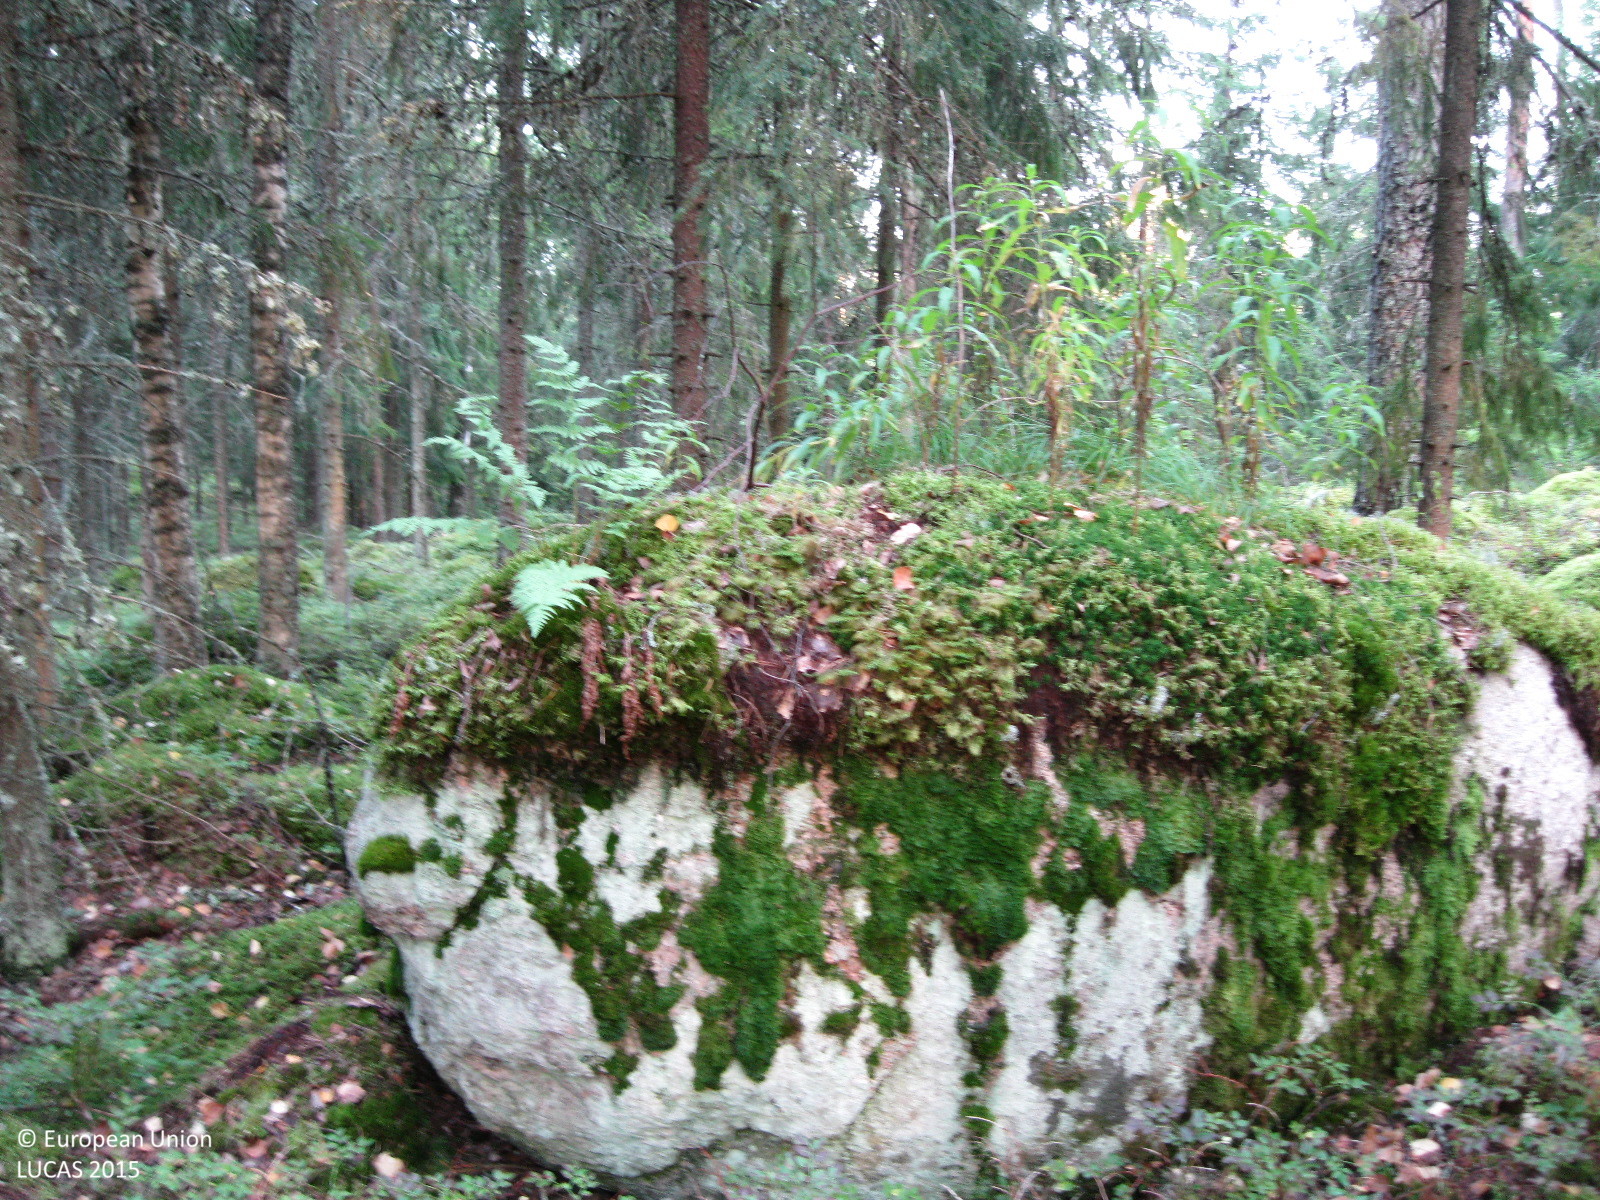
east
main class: Woodland
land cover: Other mixed woodland
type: boreal forest
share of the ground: > 75 %
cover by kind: coniferous forest trees 55 %, broadleaved forest trees 20 %, lichens and mosses 15 %, shrubs 10 %
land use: Forestry
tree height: > 5 m
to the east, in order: Other mixed woodland; Other coniferous woodland; Pine dominated mixed woodland; Paved roads, cycling and walking lanes; Electric lines; Other mixed woodland; Grass margins
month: September
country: FI
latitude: 60.7898
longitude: 24.9757
